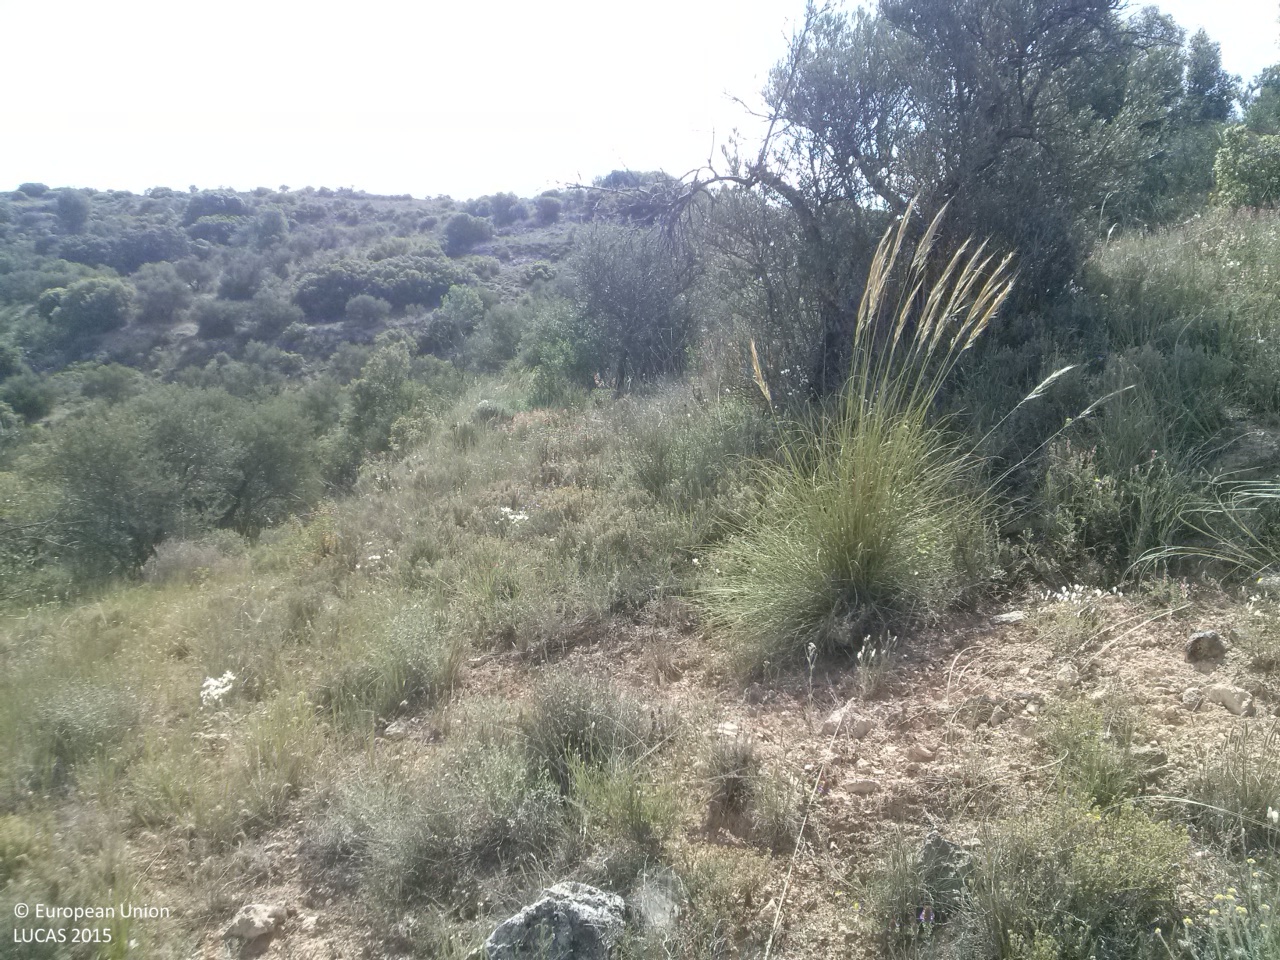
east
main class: Cropland
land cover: Olive groves
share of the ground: < 10 %
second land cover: Shrubland without tree cover
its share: 25 - 50 %
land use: Abandoned areas
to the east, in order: Olive groves; Shrubland without tree cover; Dry stone walls; Abandoned hedges; Olive groves; Dry stone walls; Broadleaved woodland; Olive groves; Broadleaved woodland; Olive groves; Abandoned hedges; Dry stone walls; Olive groves; Broadleaved woodland; Dry stone walls; Broadleaved woodland; Shrubland without tree cover
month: May
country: ES
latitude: 40.1405
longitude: -2.9239
